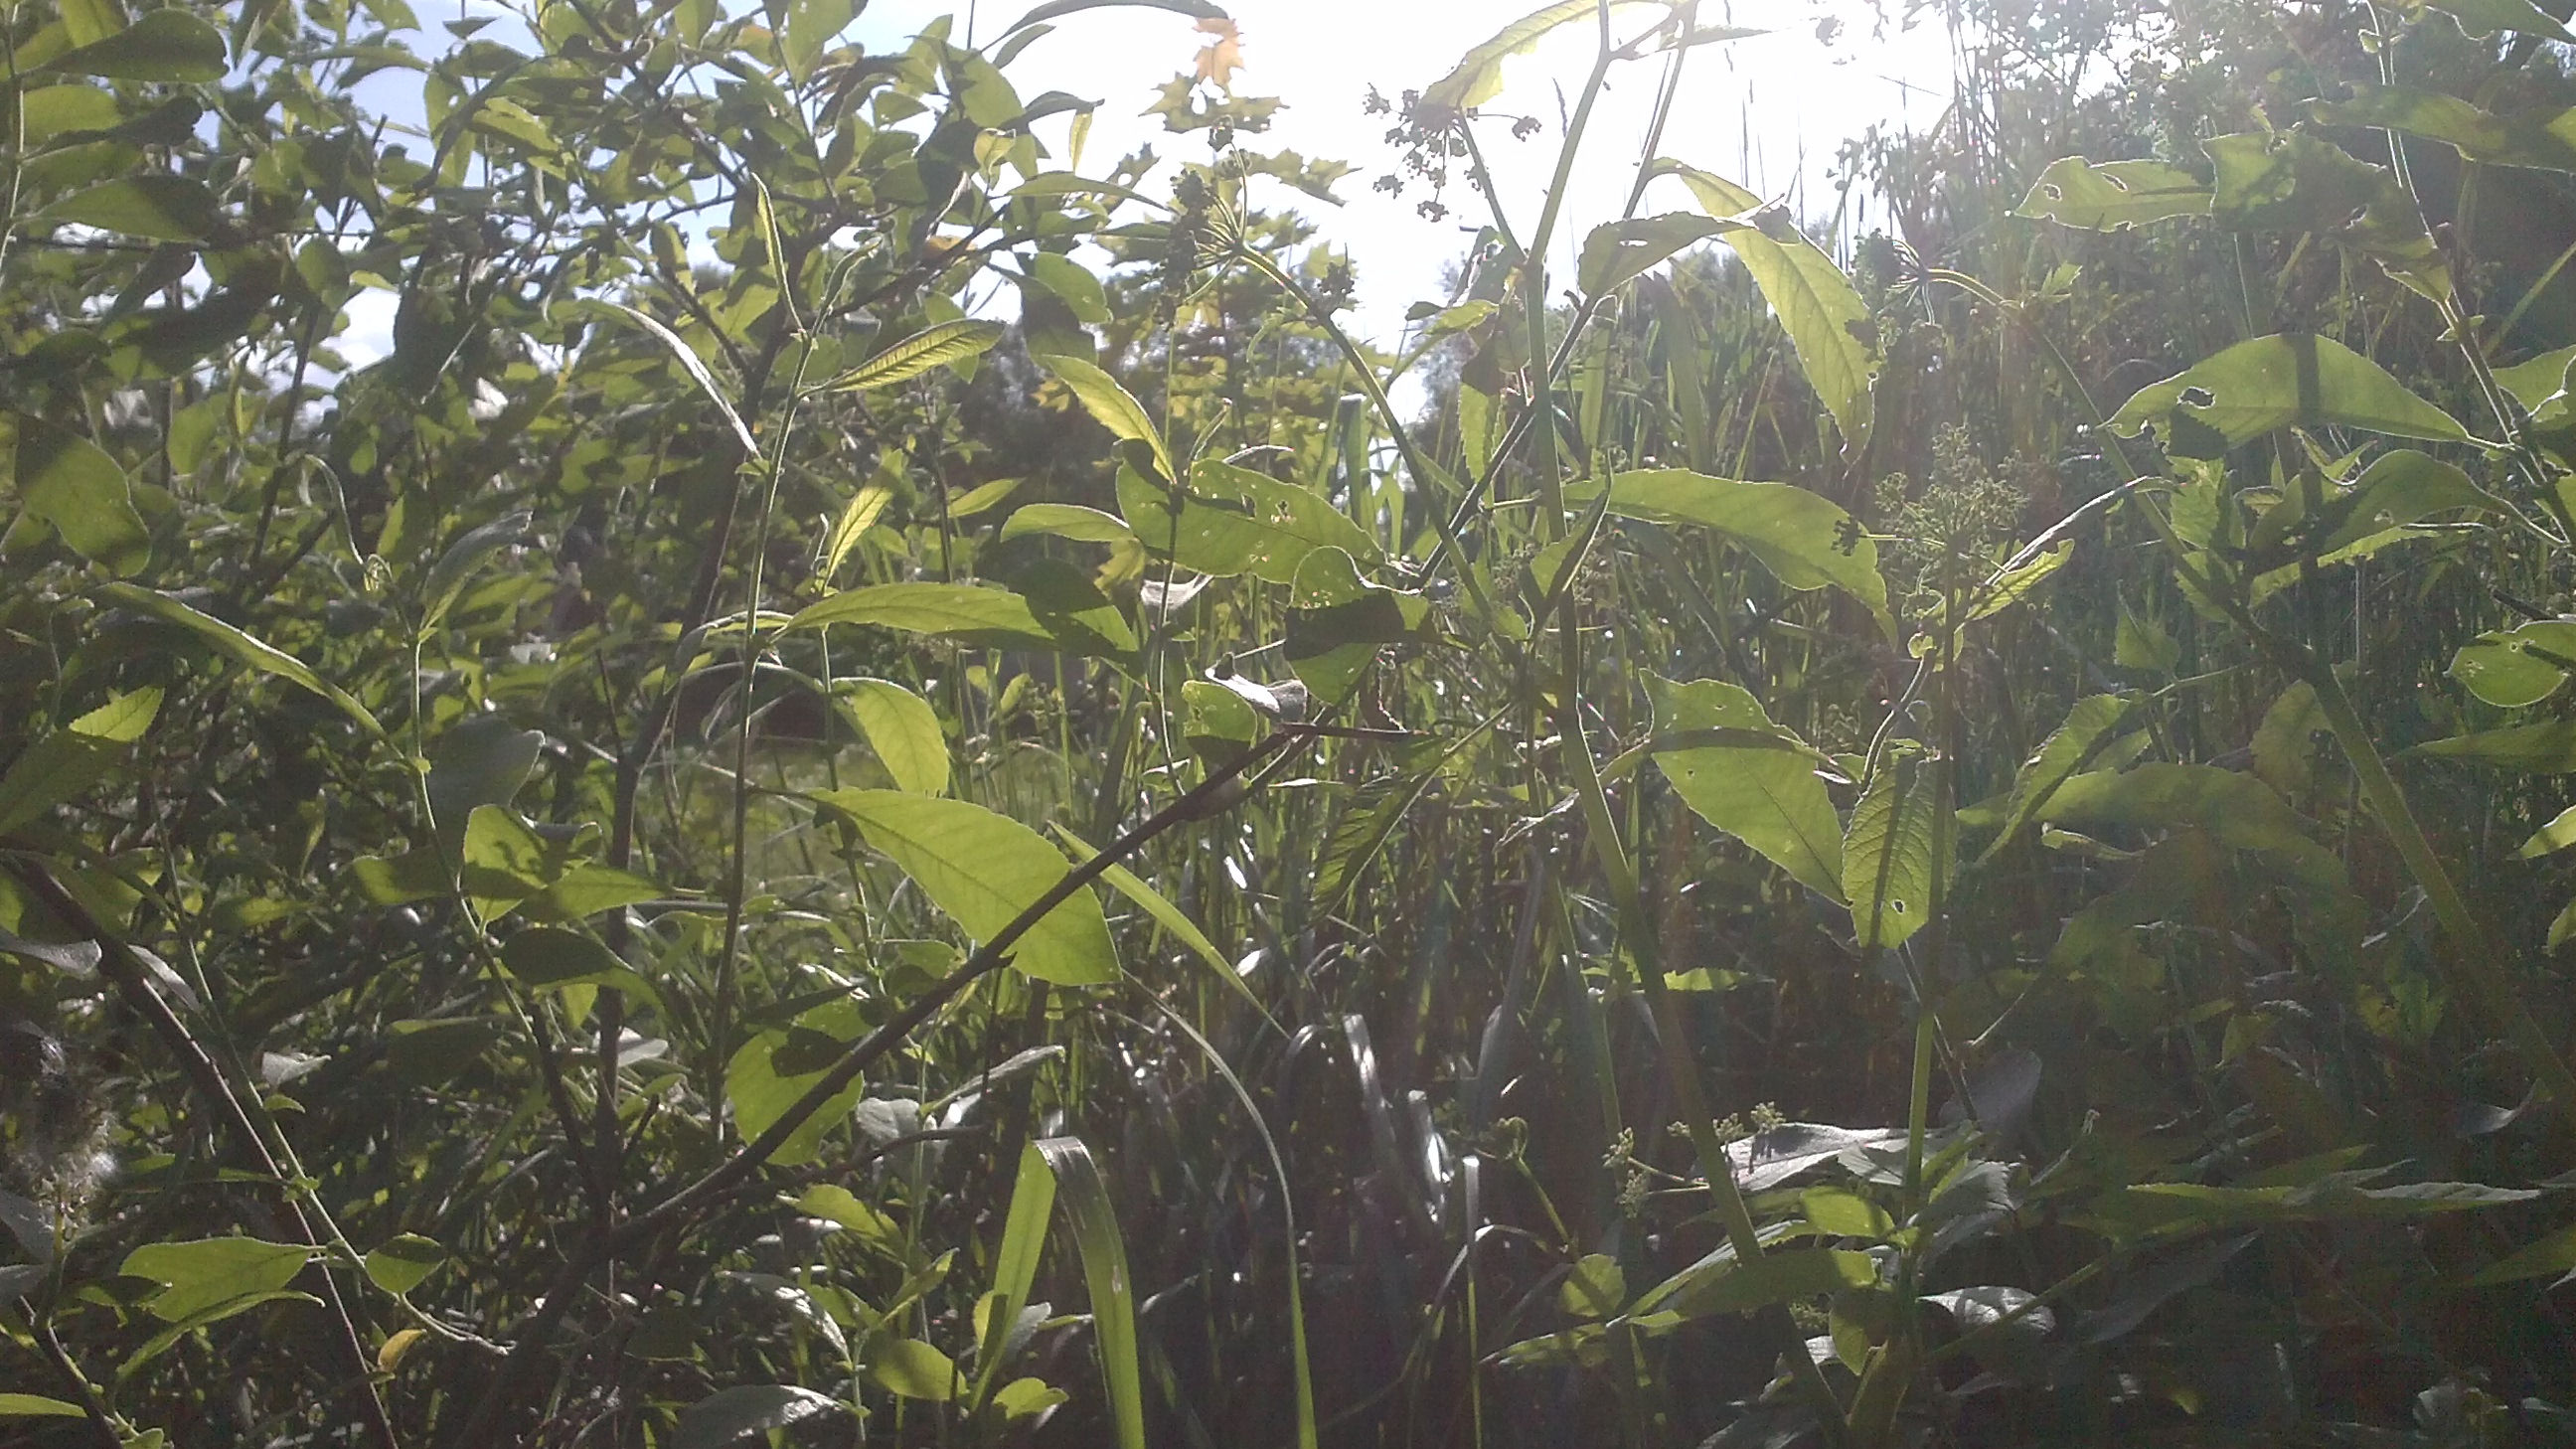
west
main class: Woodland
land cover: Broadleaved woodland
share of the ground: > 75 %
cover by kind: broadleaved forest trees 80 %, shrubs 20 %
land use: Semi-natural and natural areas not in use
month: June
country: LV
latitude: 56.4399
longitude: 27.4184
